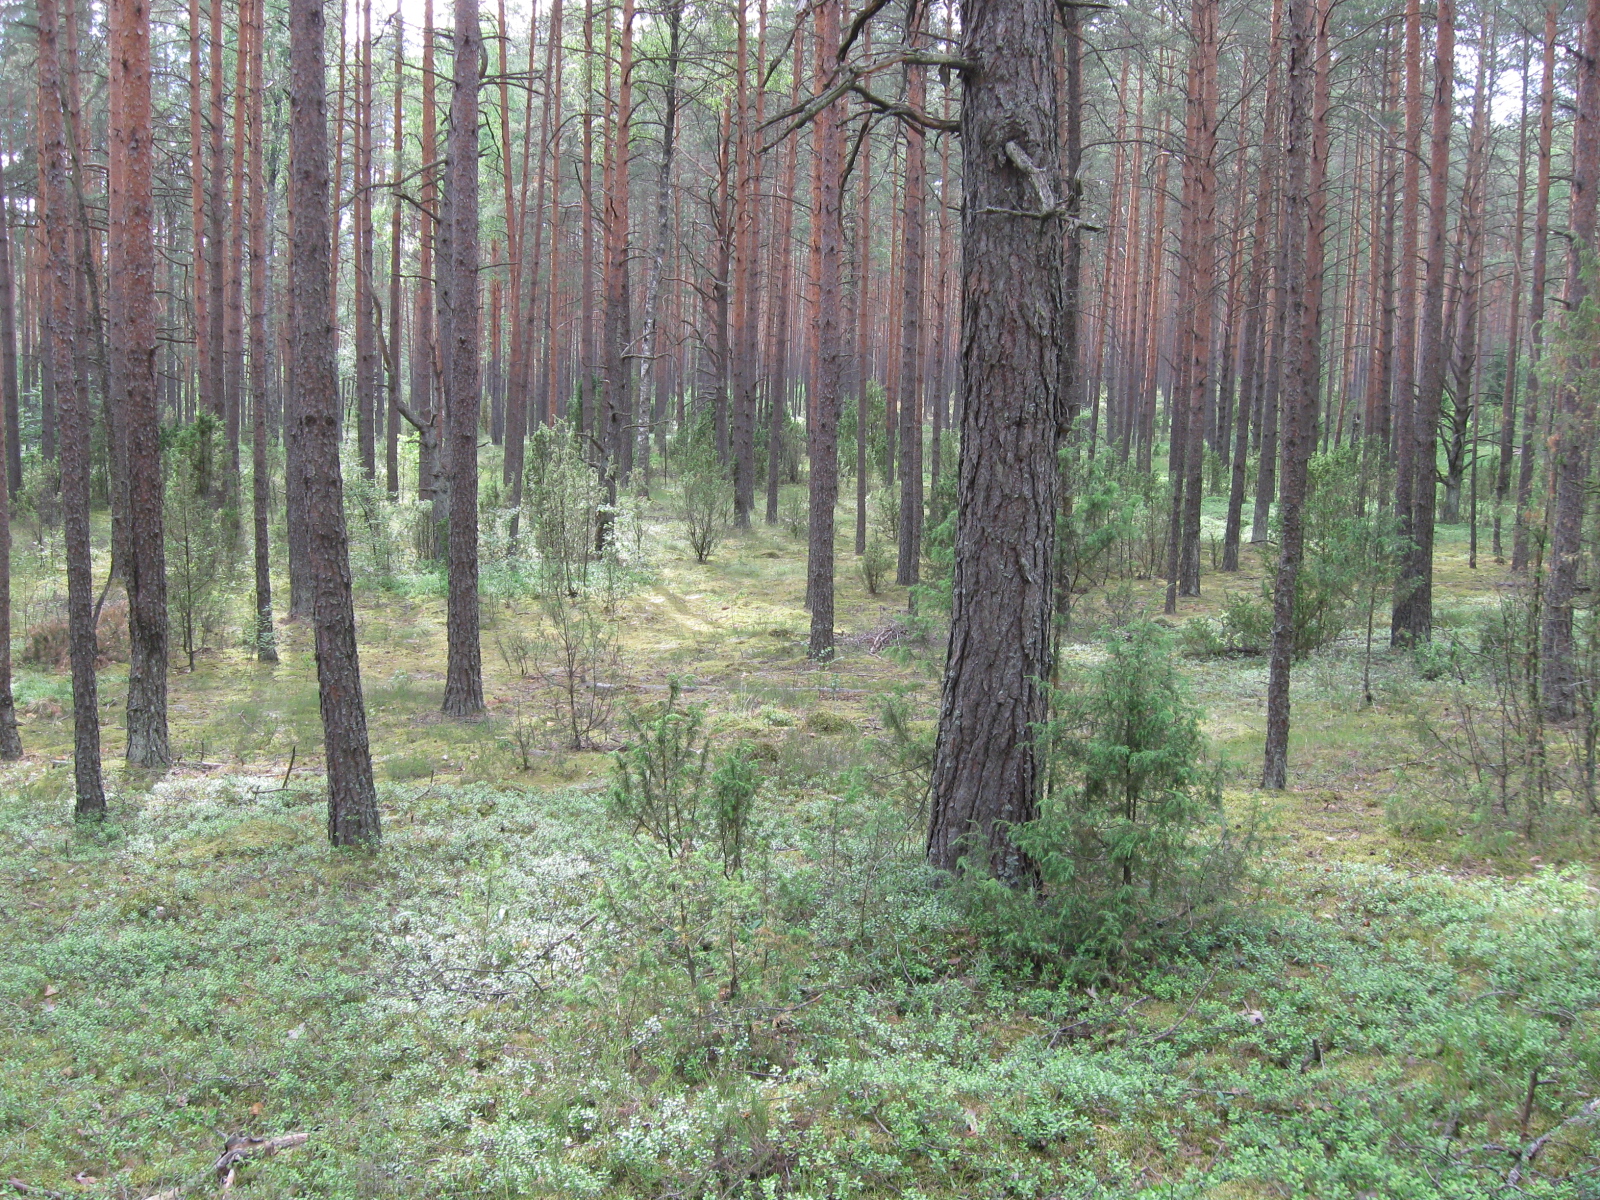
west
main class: Woodland
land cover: Pine dominated coniferous woodland
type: hemiboreal forest and nemoral coniferous forest and mixed broadleaved-coniferous forest
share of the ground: > 75 %
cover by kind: coniferous forest trees 80 %, lichens and mosses 15 %, herbaceous plants 5 %
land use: Forestry
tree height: > 5 m
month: June
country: LT
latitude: 54.2084
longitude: 24.6263
